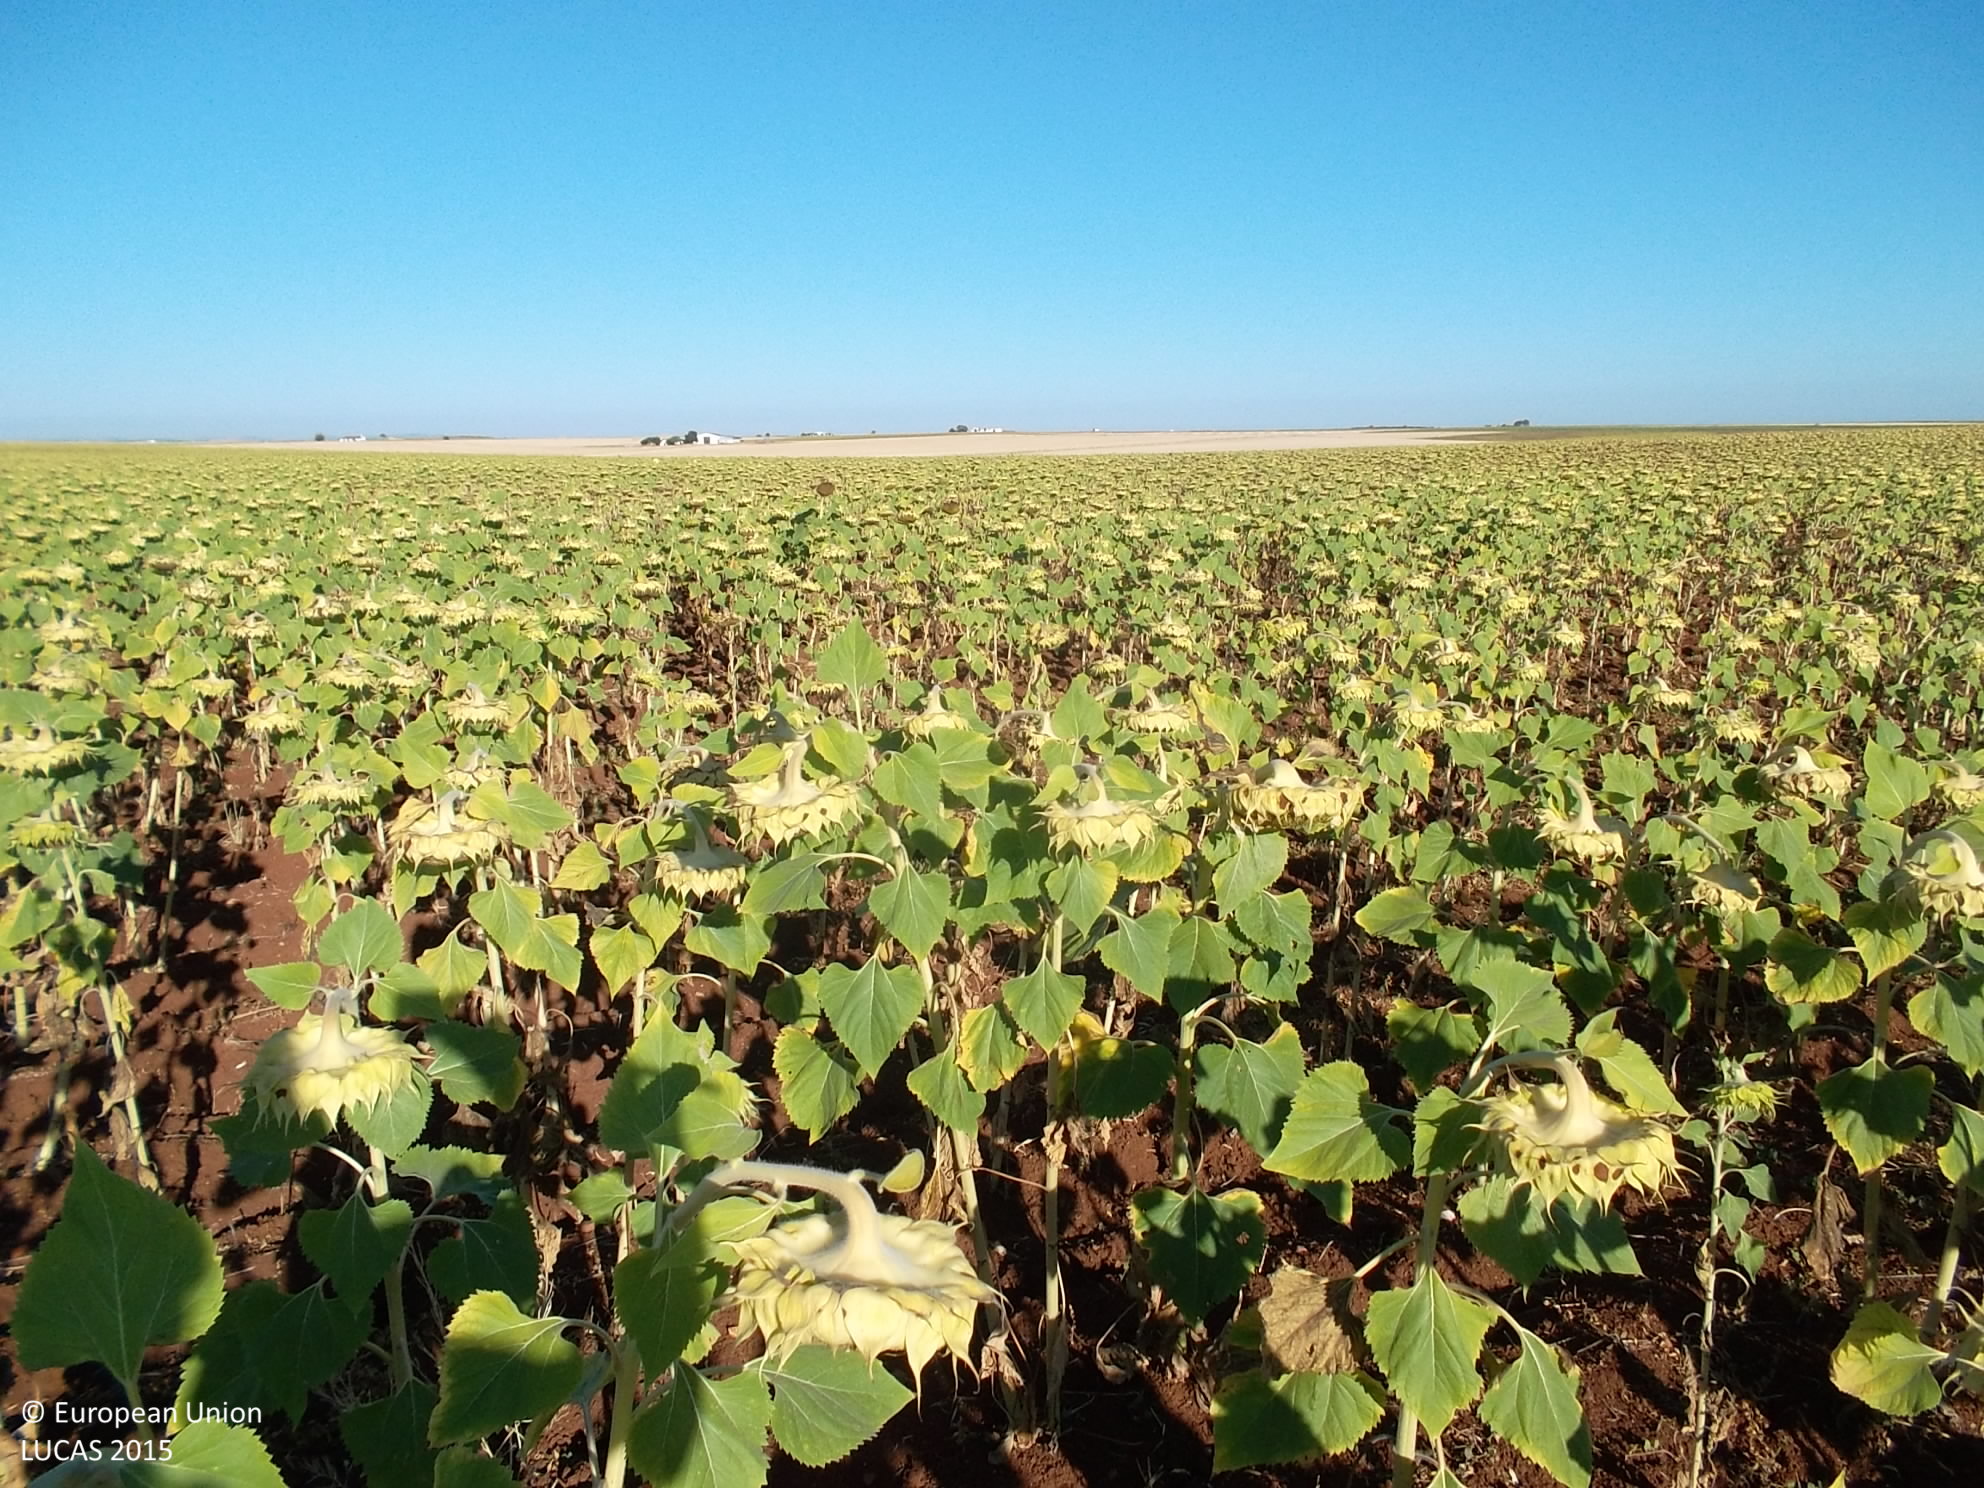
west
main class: Cropland
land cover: Sunflower
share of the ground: > 75 %
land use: Agriculture (excluding fallow land and kitchen gardens)
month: July
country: ES
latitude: 38.3465
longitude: -5.7236
